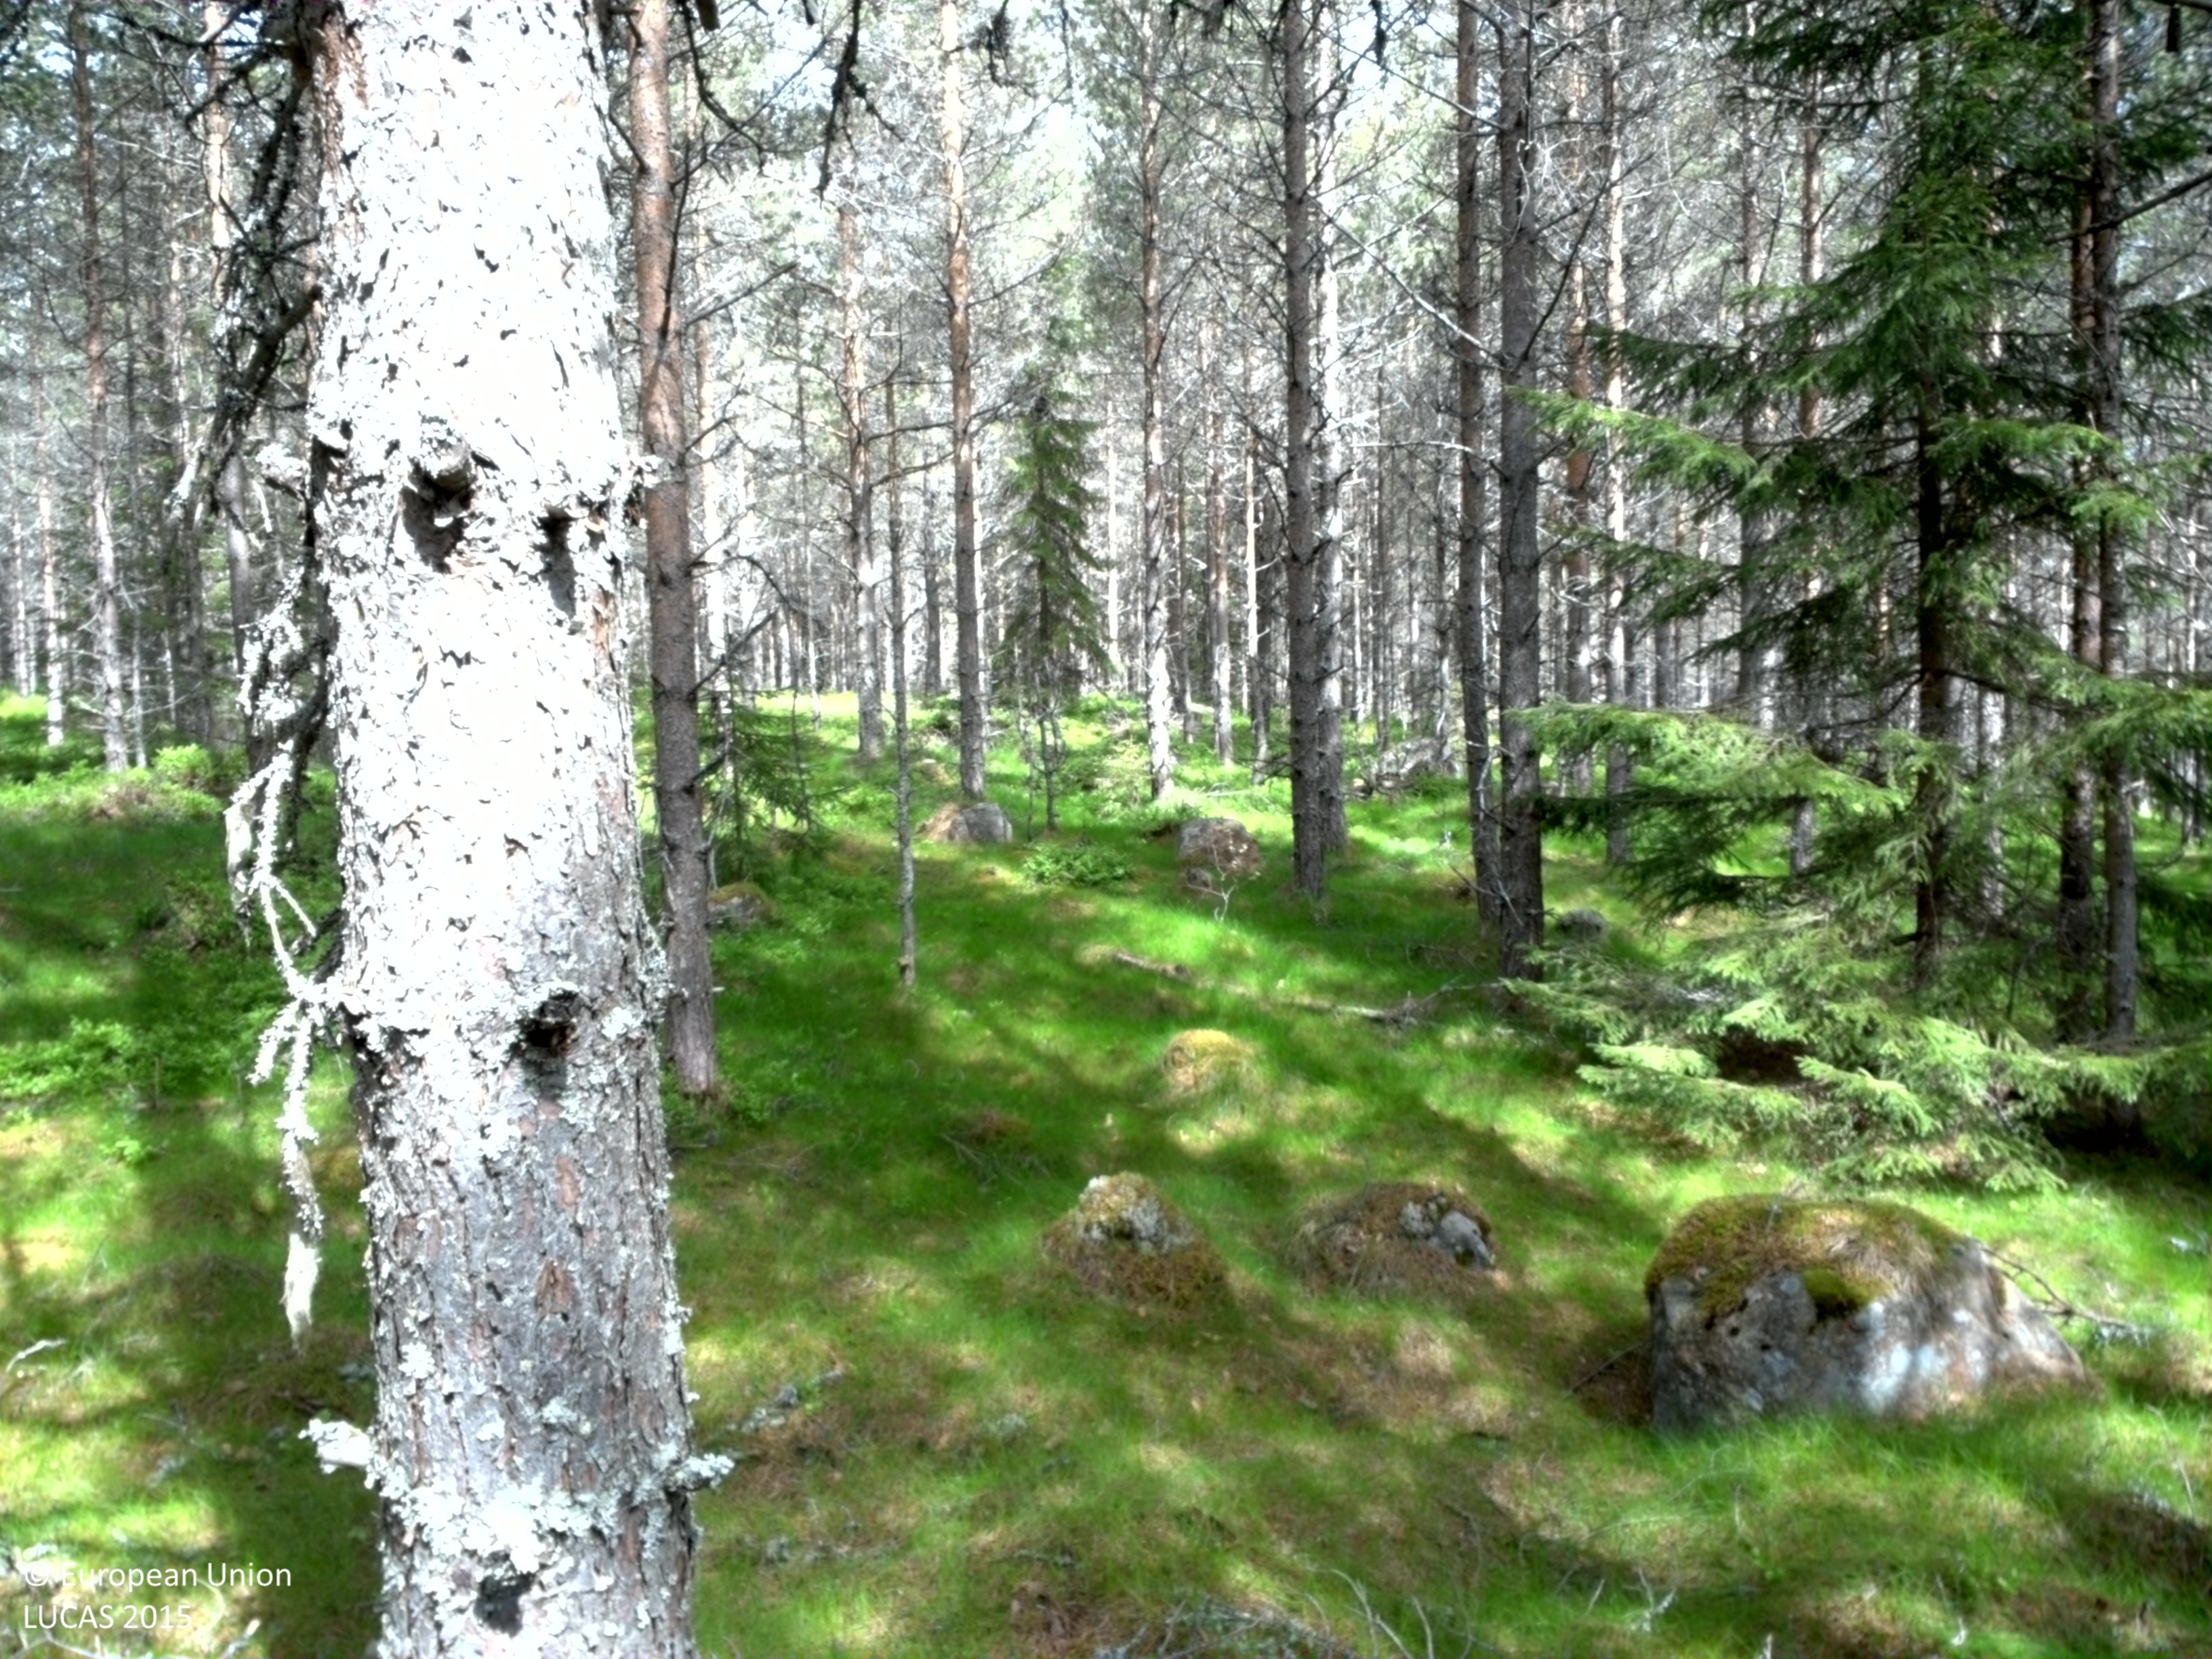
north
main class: Woodland
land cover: Pine dominated coniferous woodland
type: boreal forest
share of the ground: 50 - 75 %
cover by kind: coniferous forest trees 60 %, herbaceous plants 30 %, shrubs 10 %
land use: Forestry
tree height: > 5 m
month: June
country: SE
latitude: 60.3246
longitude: 13.1958
